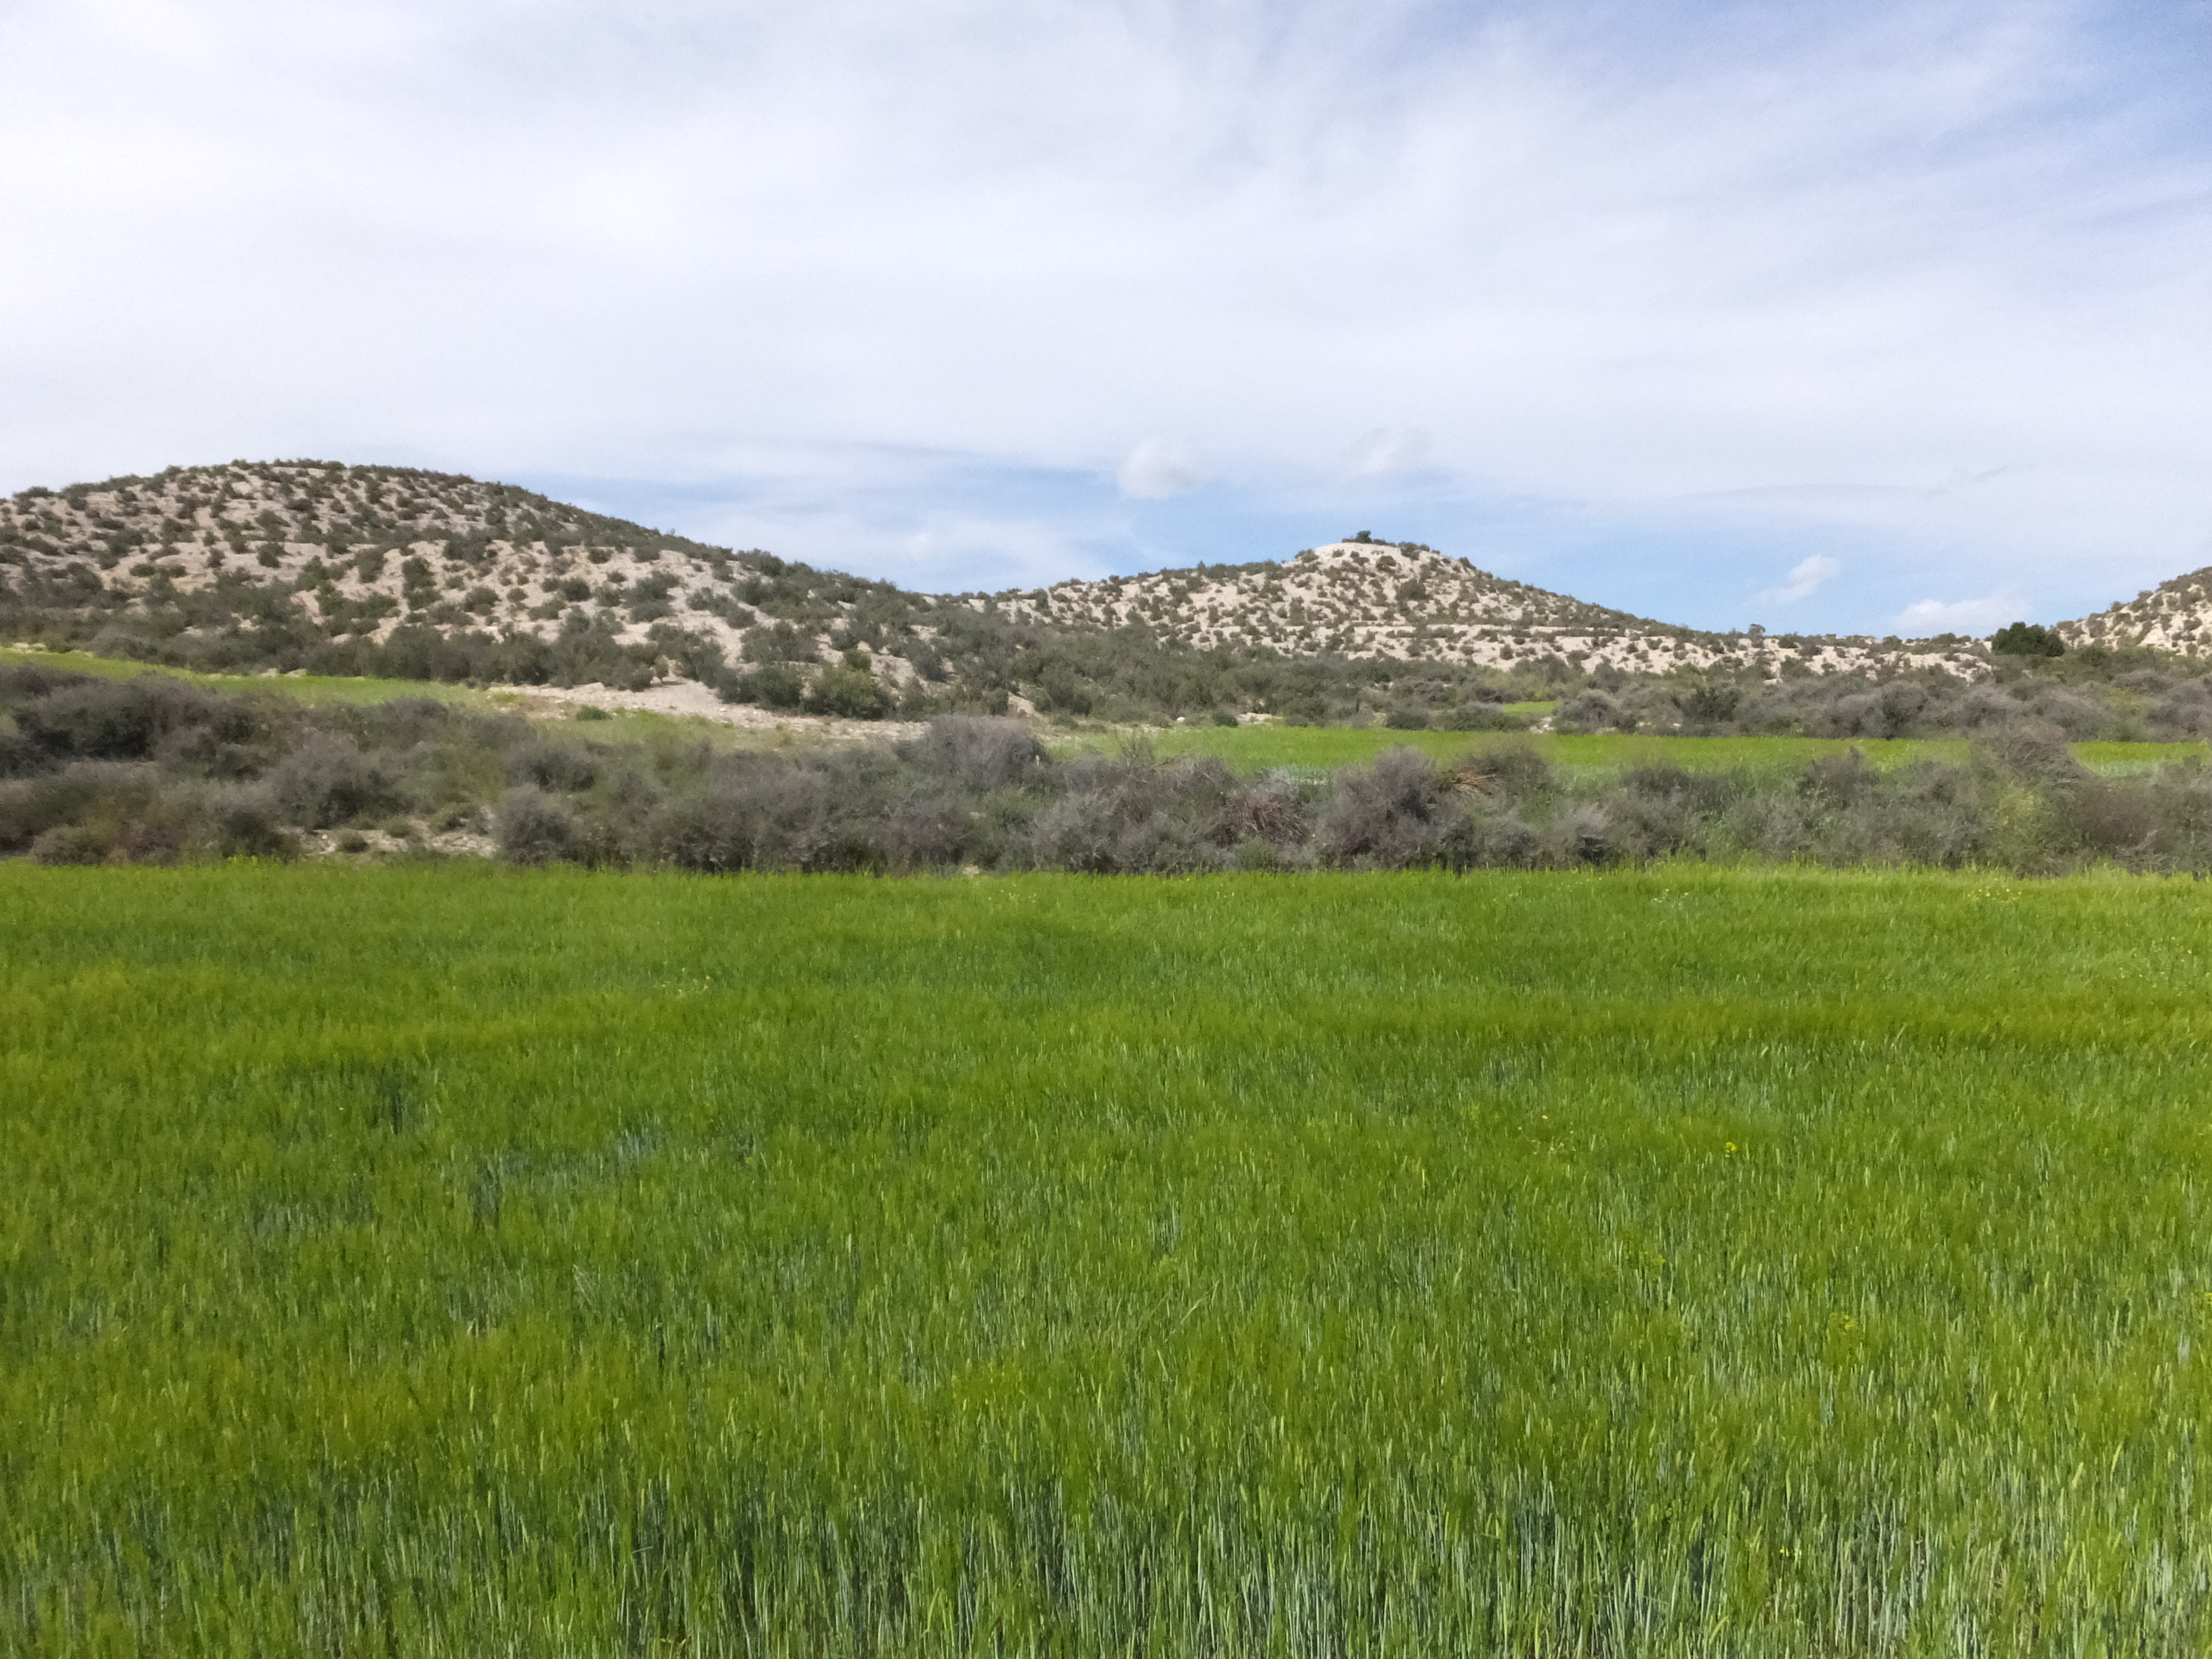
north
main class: Cropland
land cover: Barley
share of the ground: > 75 %
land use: Agriculture (excluding fallow land and kitchen gardens)
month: April
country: ES
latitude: 41.6104
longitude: -0.3737
